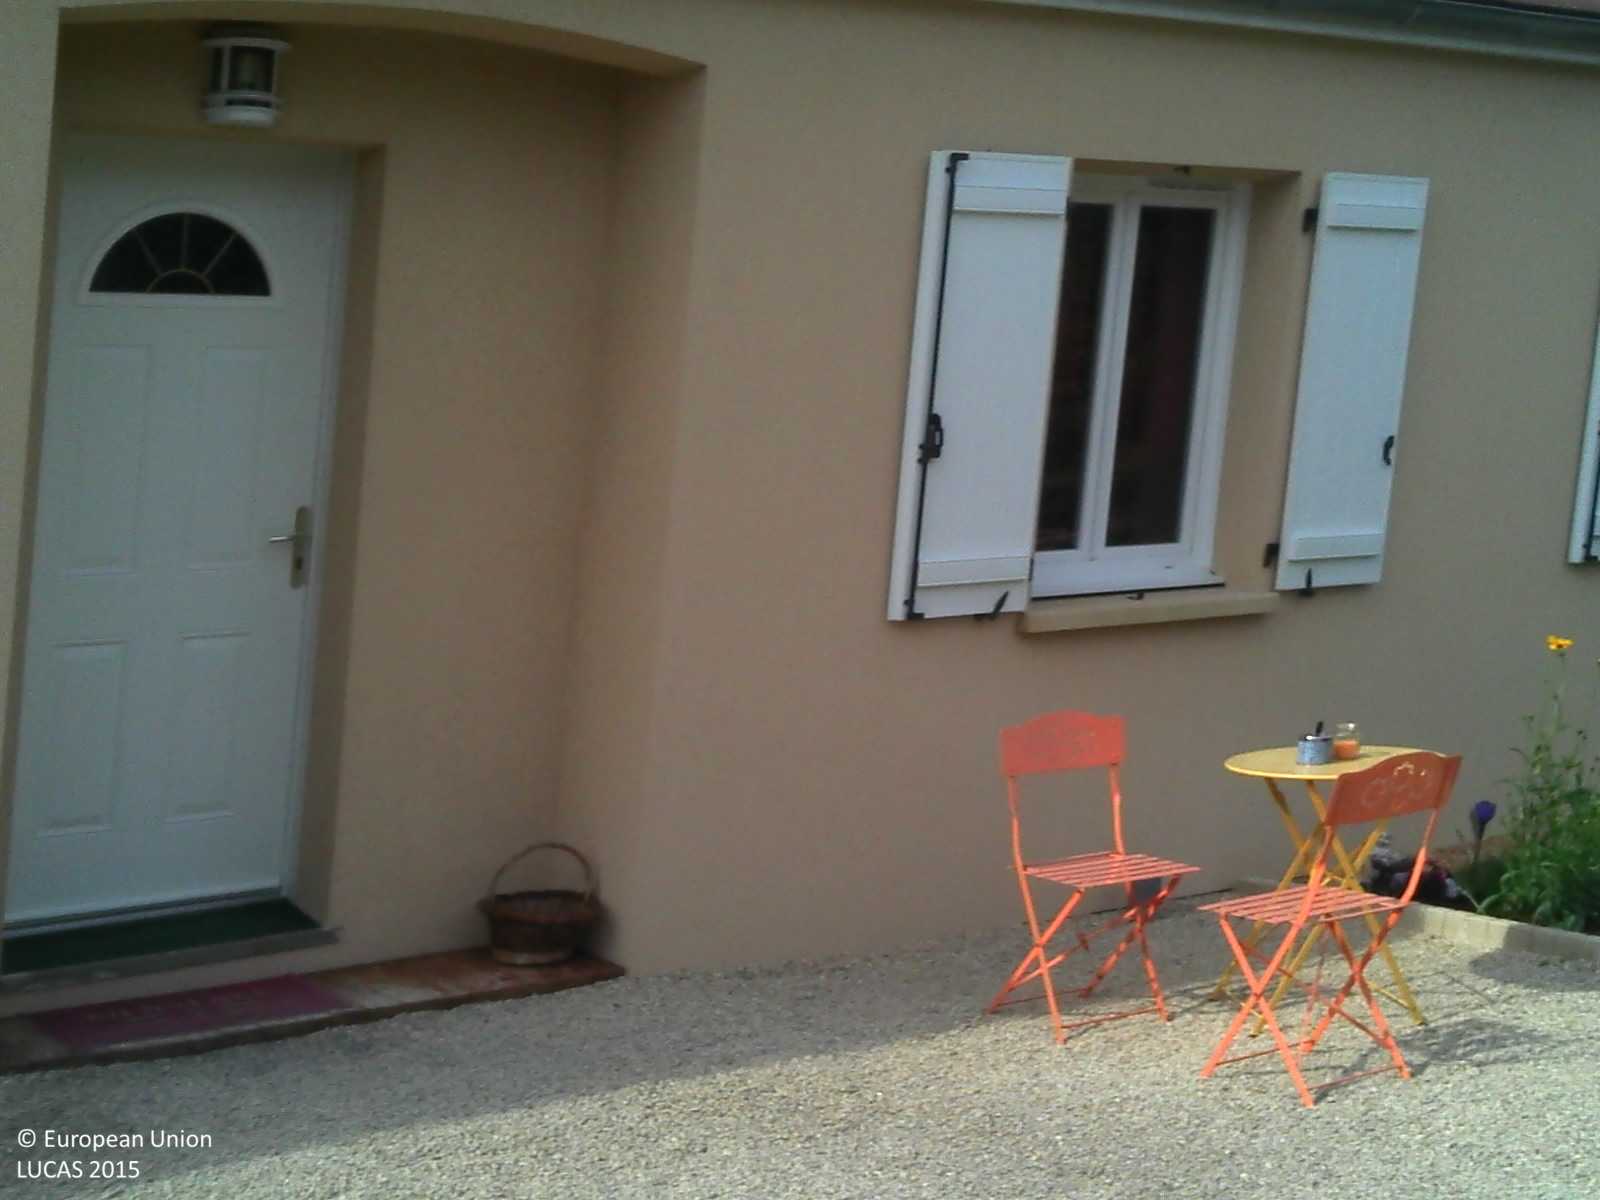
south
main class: Grassland
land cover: Grassland with sparse tree/shrub cover
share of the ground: > 75 %
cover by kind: herbaceous plants 95 %, broadleaved forest trees 5 %
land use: Agriculture (excluding fallow land and kitchen gardens)
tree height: < 5 m
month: June
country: FR
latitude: 47.5265
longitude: 1.4187
